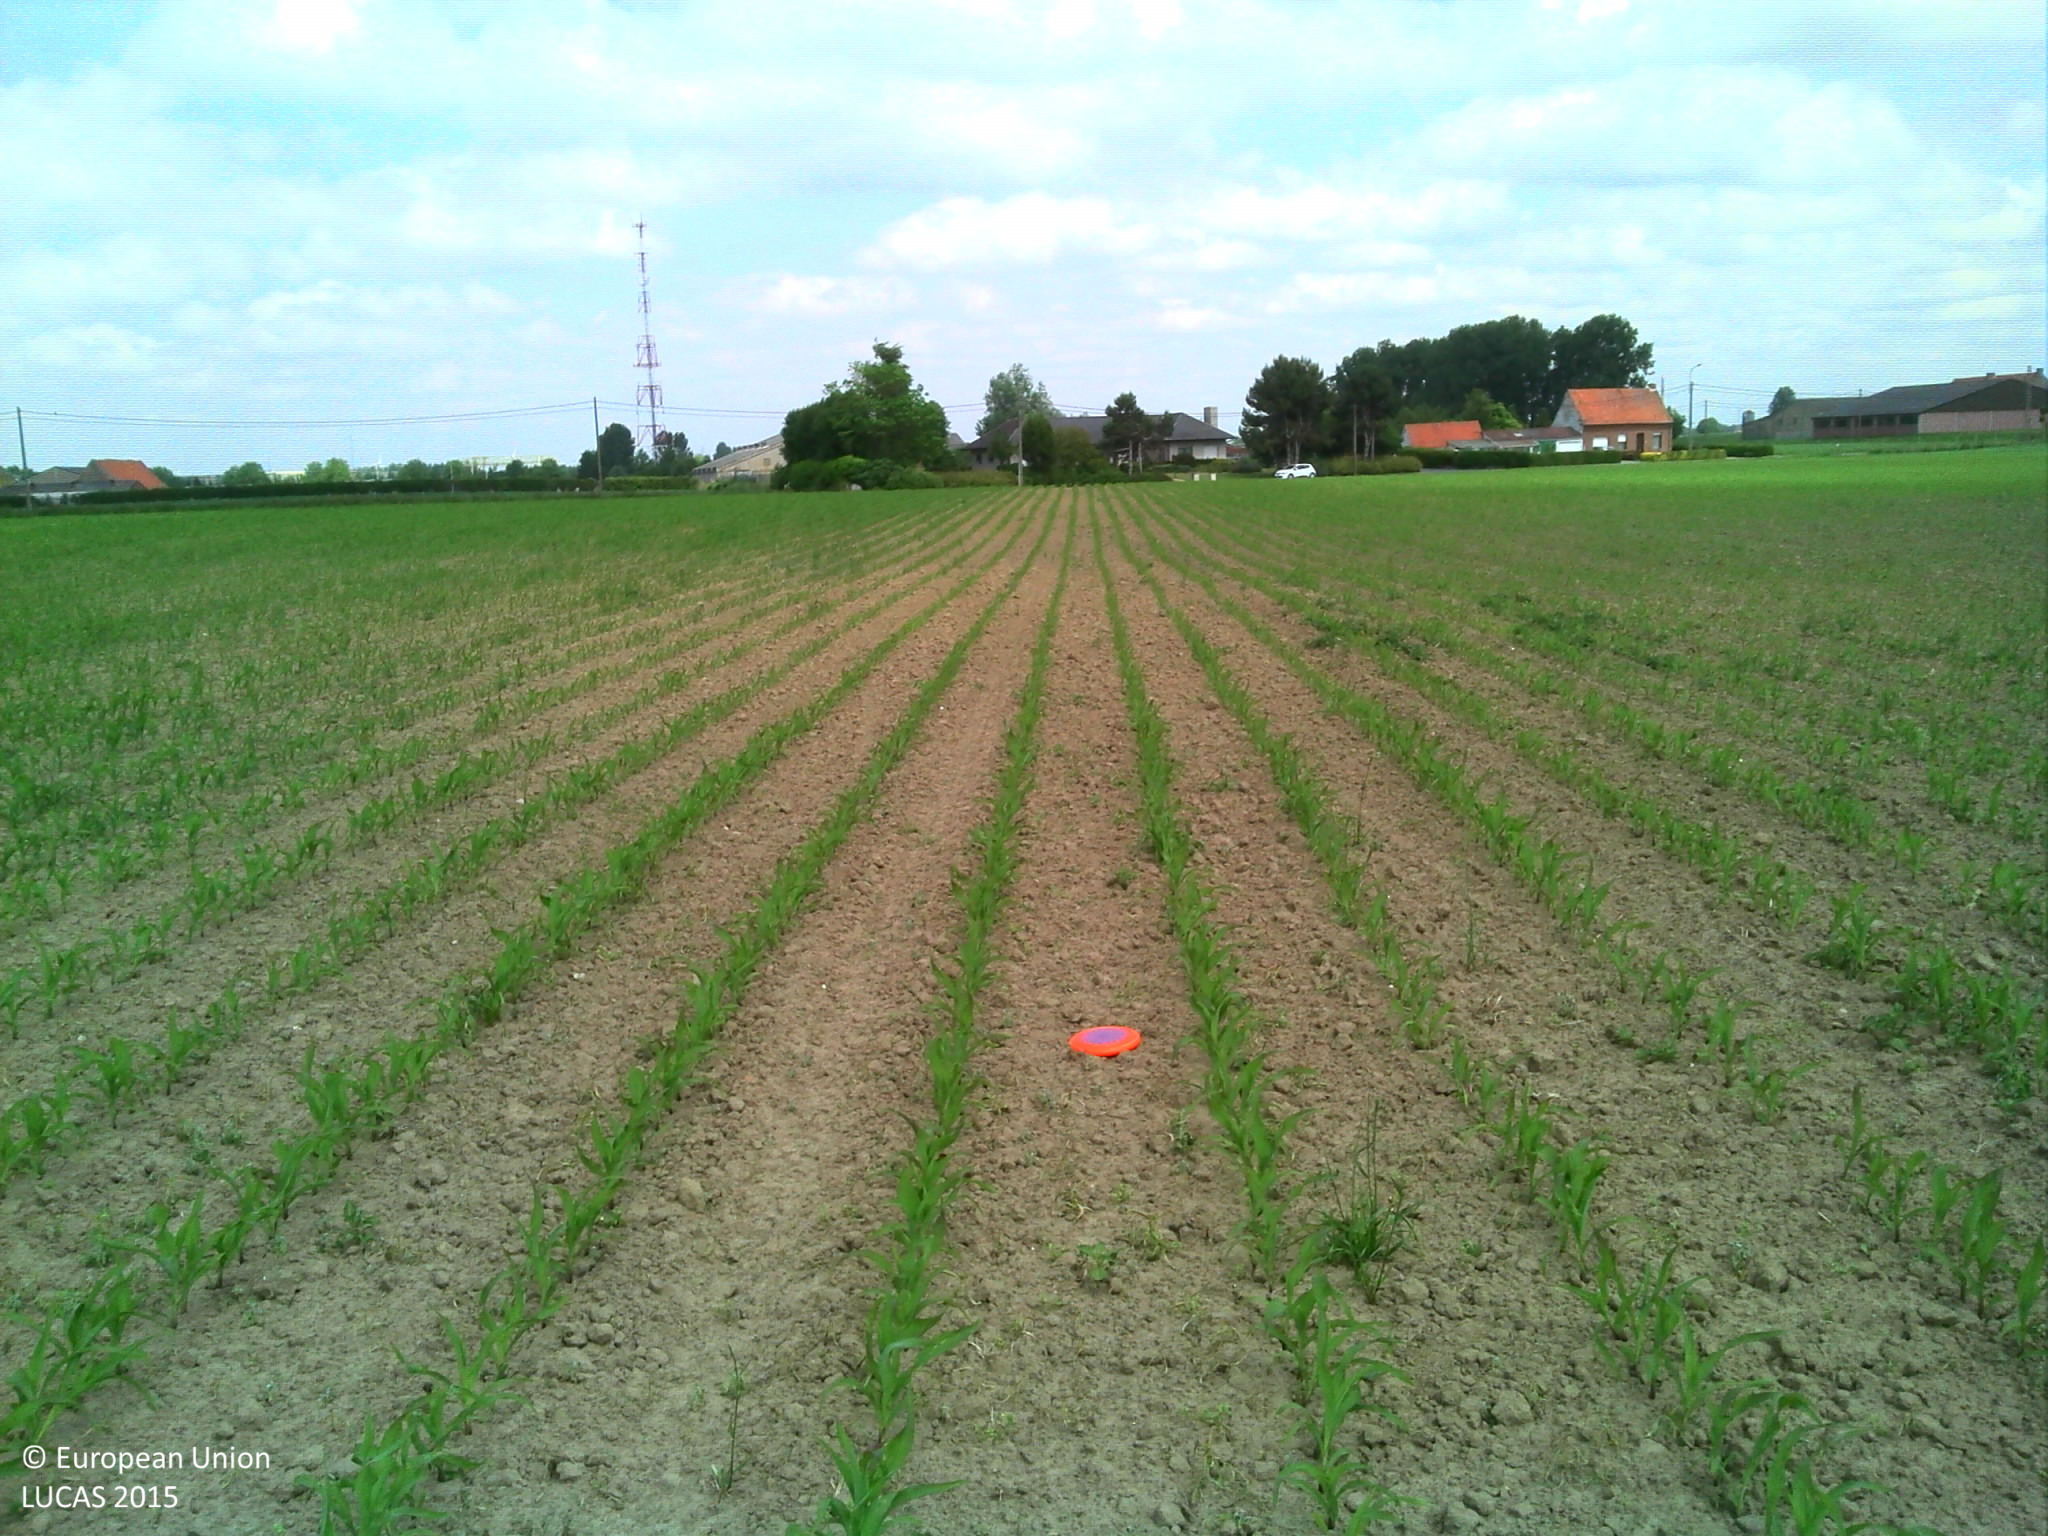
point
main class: Cropland
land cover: Maize
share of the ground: 10 - 25 %
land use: Agriculture (excluding fallow land and kitchen gardens)
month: June
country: BE
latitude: 50.8422
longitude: 2.8172
